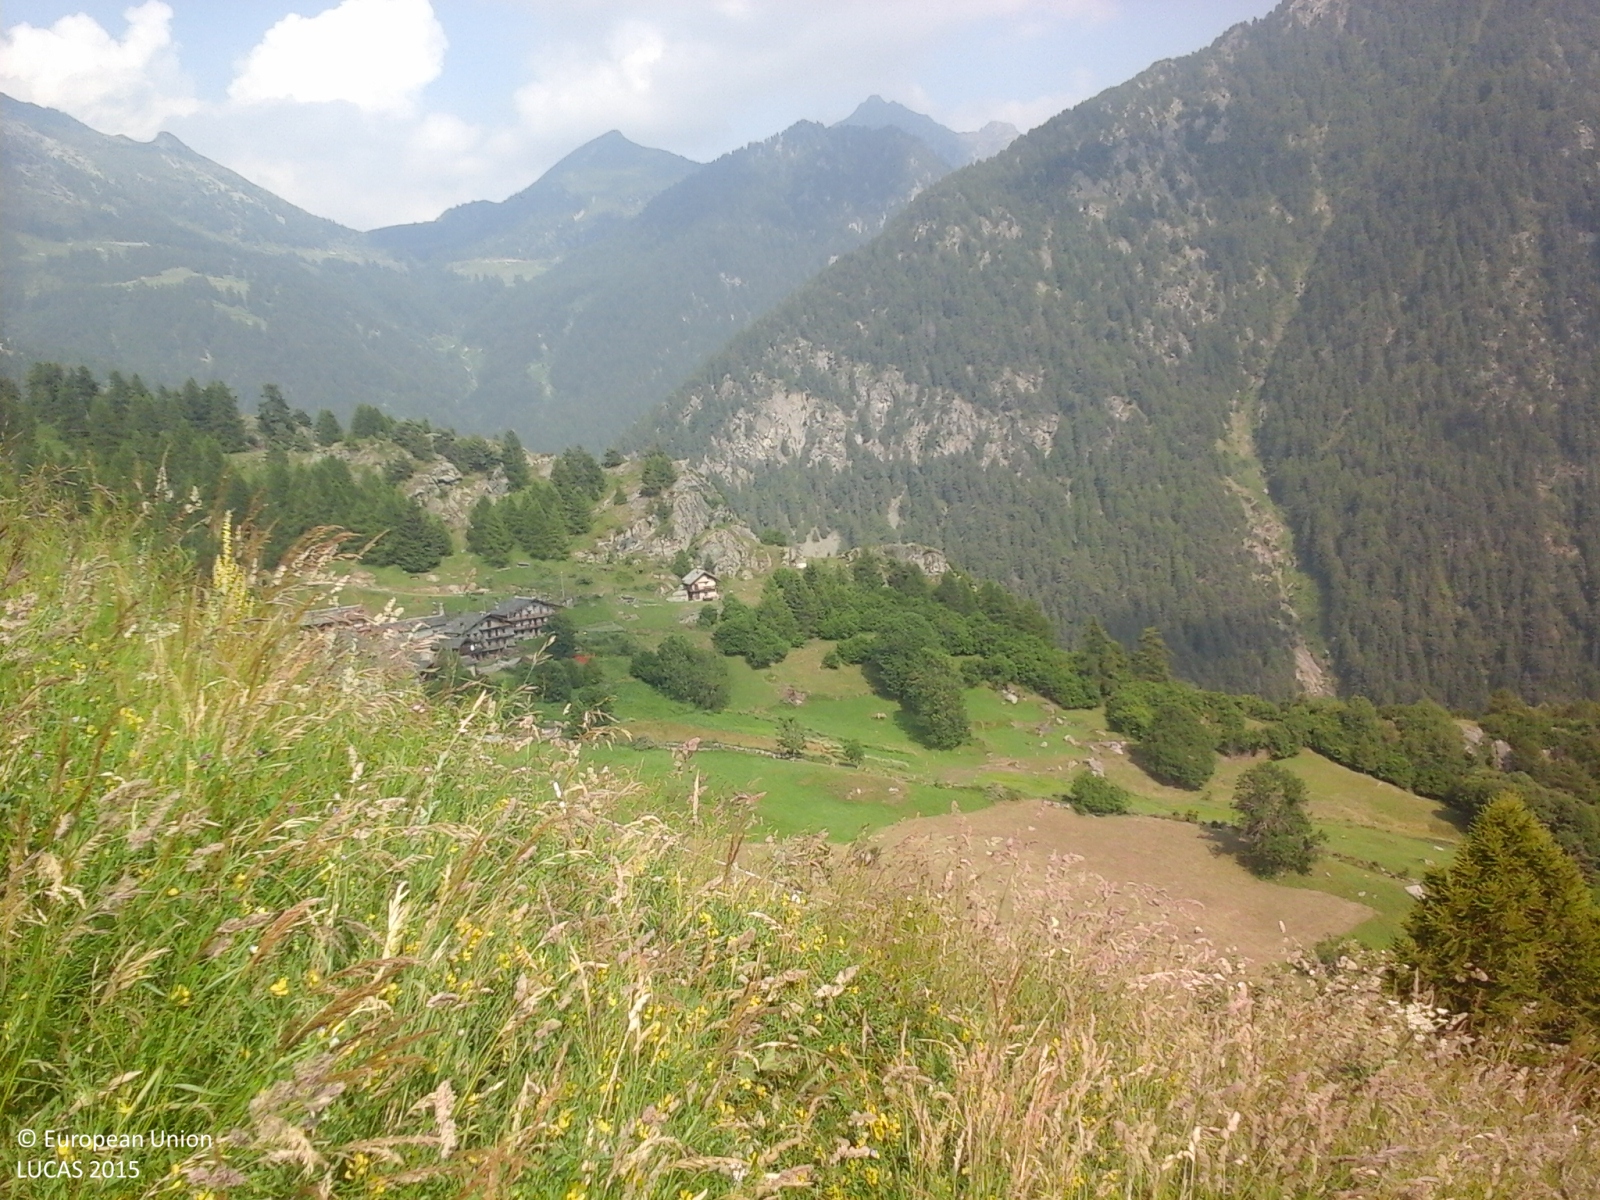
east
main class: Grassland
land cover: Grassland without tree/shrub cover
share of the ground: > 75 %
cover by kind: herbaceous plants 100 %
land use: Agriculture (excluding fallow land and kitchen gardens)
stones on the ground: < 10 %
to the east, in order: Grassland without tree/shrub cover; Dry stone walls; Tracks; Grassland without tree/shrub cover; Rock outcrops; Grassland without tree/shrub cover; Artificial constructions; Paved roads, cycling and walking lanes; Fences; Artificial constructions; Grassland without tree/shrub cover; Tracks; Grassland without tree/shrub cover; Rock outcrops; Tracks; Managed hedges; Dry stone walls; Grassland without tree/shrub cover; Dry stone walls; Grassland without tree/shrub cover; Dry stone walls; Grassland without tree/shrub cover; Ditches and canals; Grassland without tree/shrub cover; Electric lines; Grassland without tree/shrub cover; Ditches and canals; Grassland without tree/shrub cover; Rock outcrops; Grassland without tree/shrub cover
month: July
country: IT
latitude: 45.7509
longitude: 7.7536
